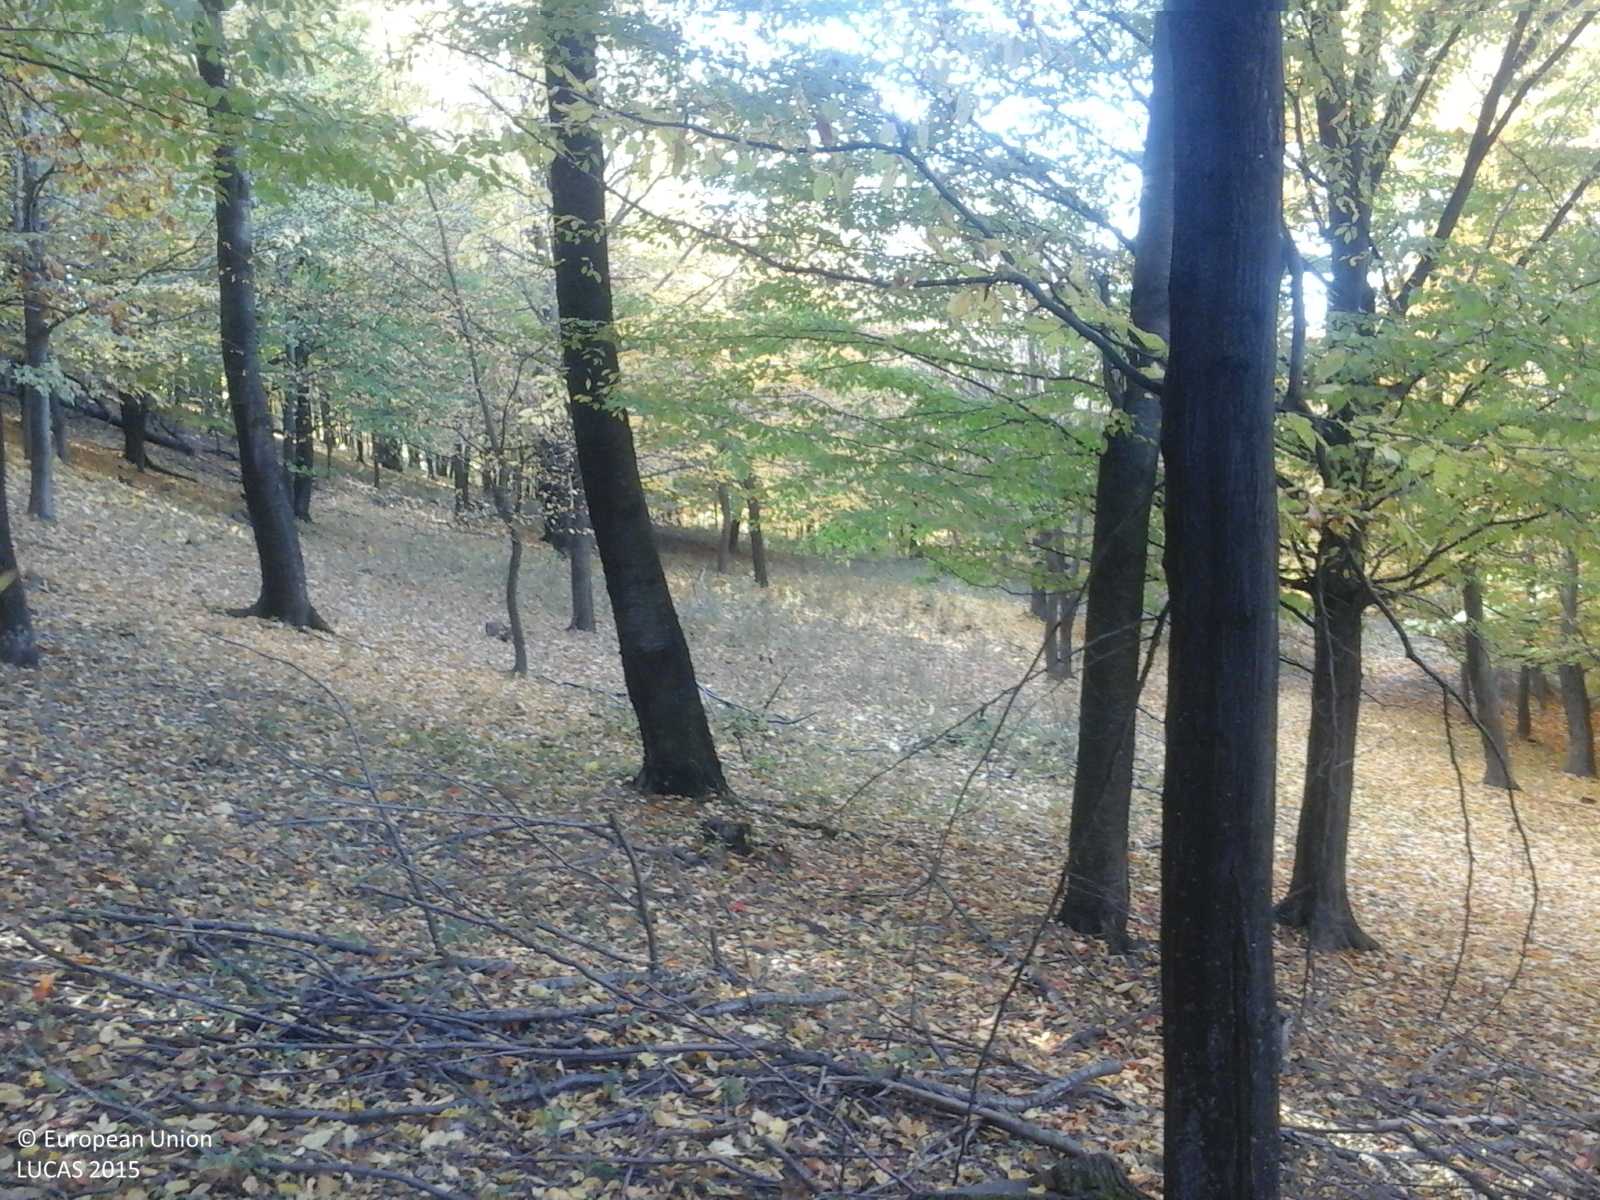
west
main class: Woodland
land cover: Broadleaved woodland
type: beech forest
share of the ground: > 75 %
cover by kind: broadleaved forest trees 100 %
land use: Forestry
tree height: > 5 m
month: October
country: RO
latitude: 46.0696
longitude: 27.0699
